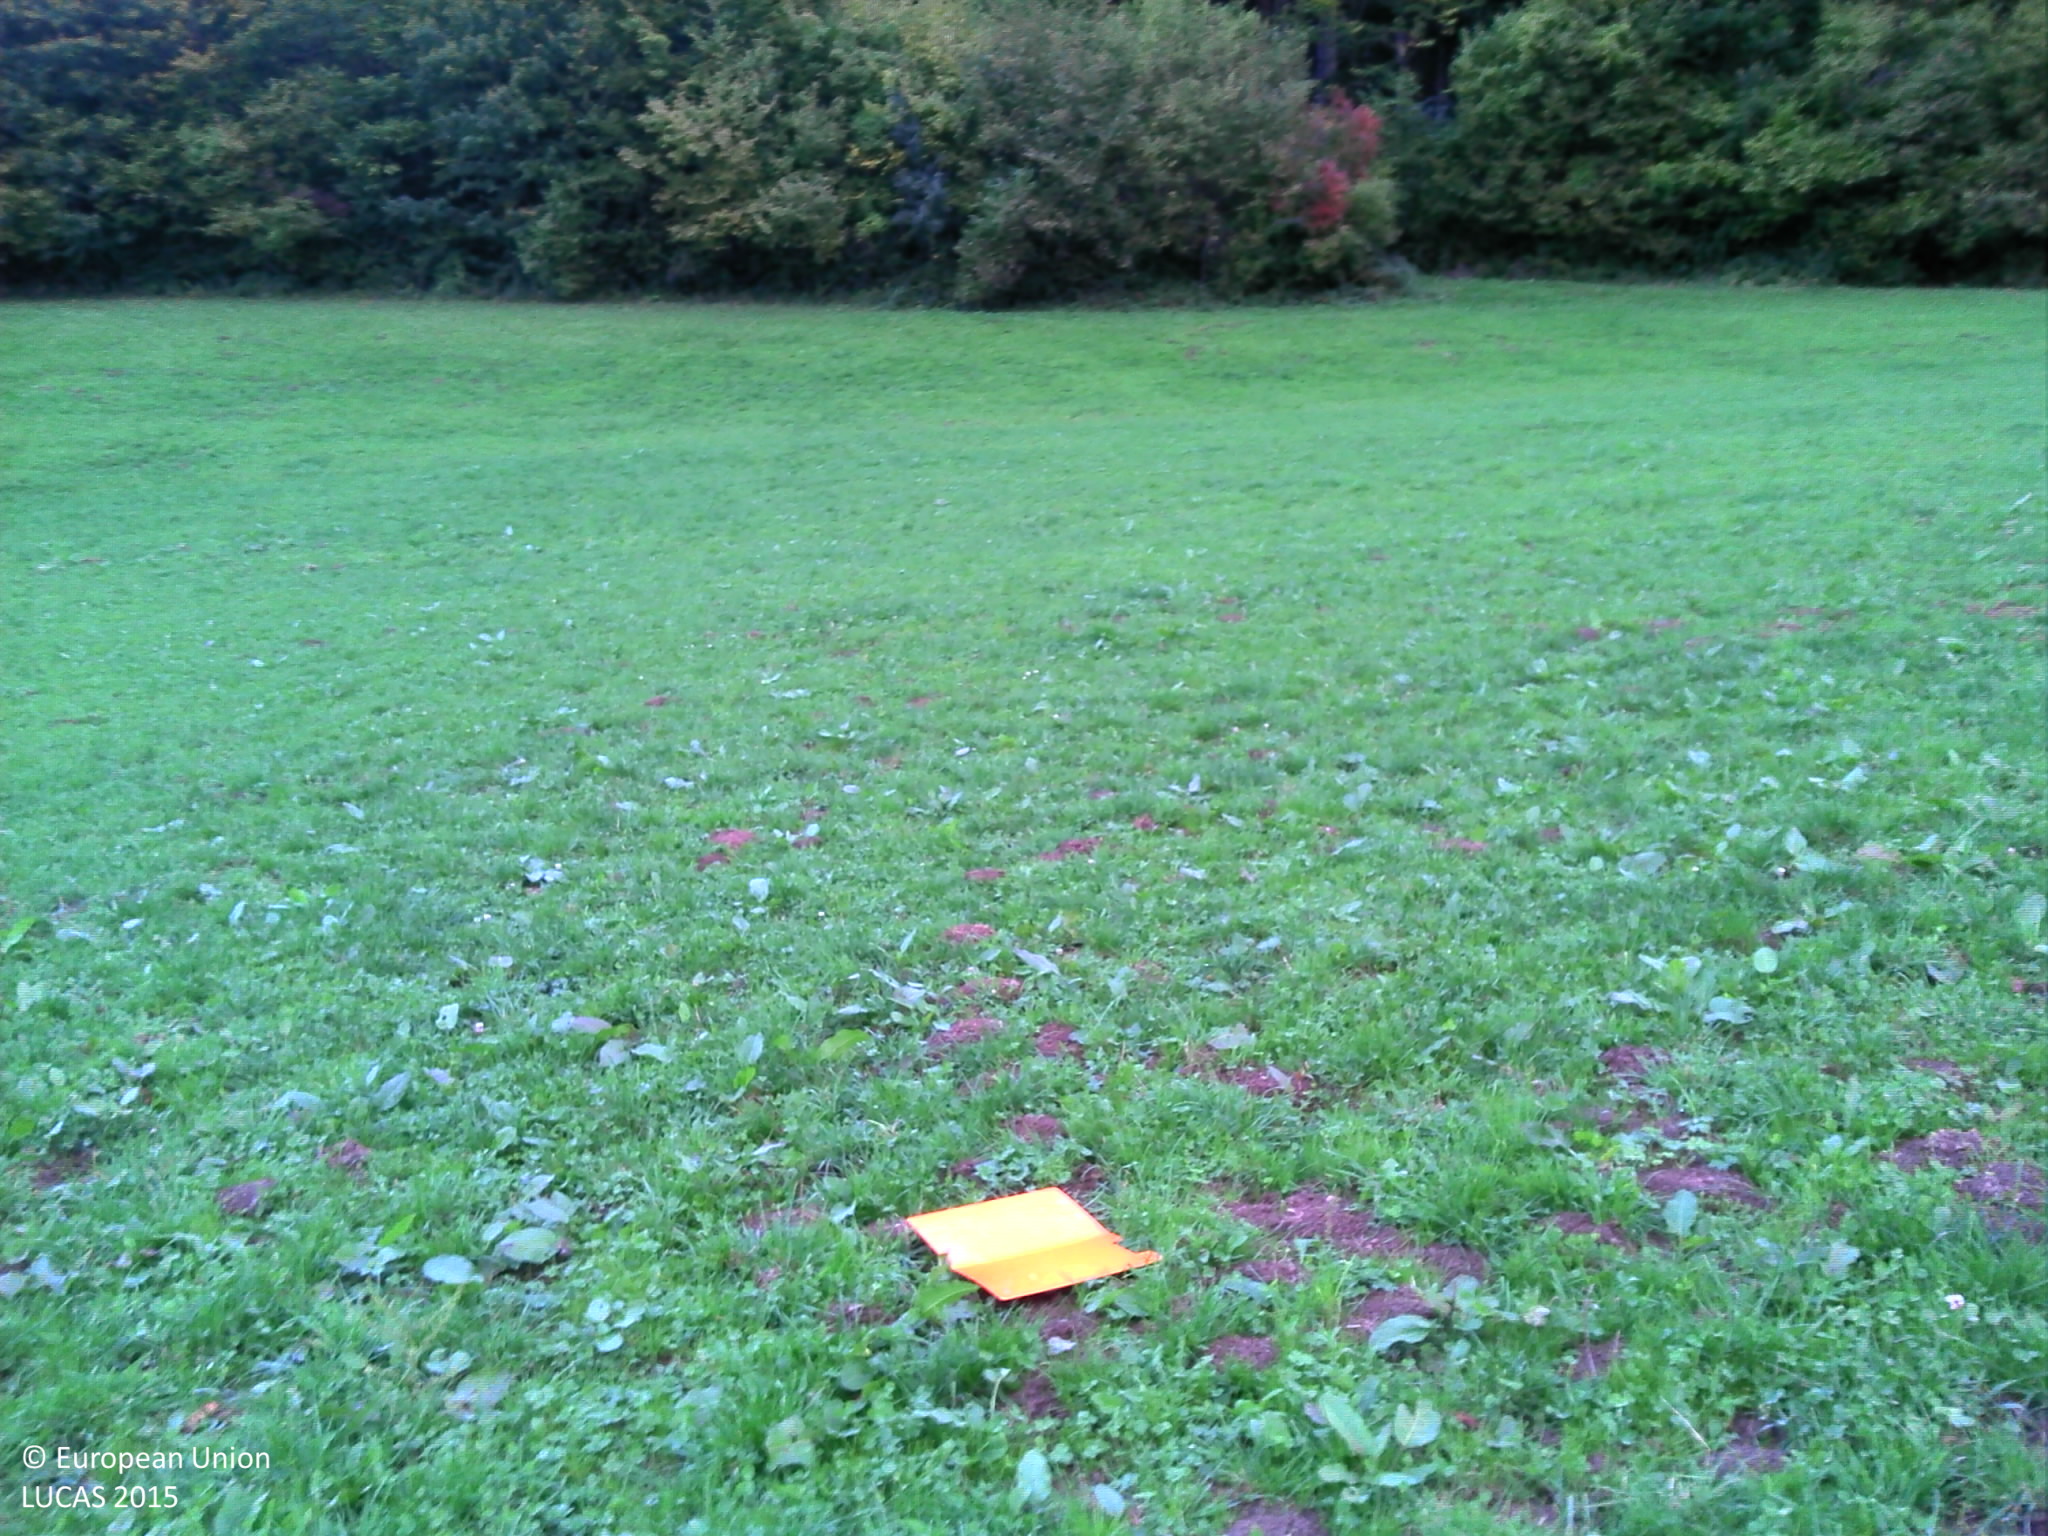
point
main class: Grassland
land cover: Grassland without tree/shrub cover
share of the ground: > 75 %
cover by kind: herbaceous plants 100 %
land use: Agriculture (excluding fallow land and kitchen gardens)
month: October
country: FR
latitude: 47.0891
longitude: 6.0369
